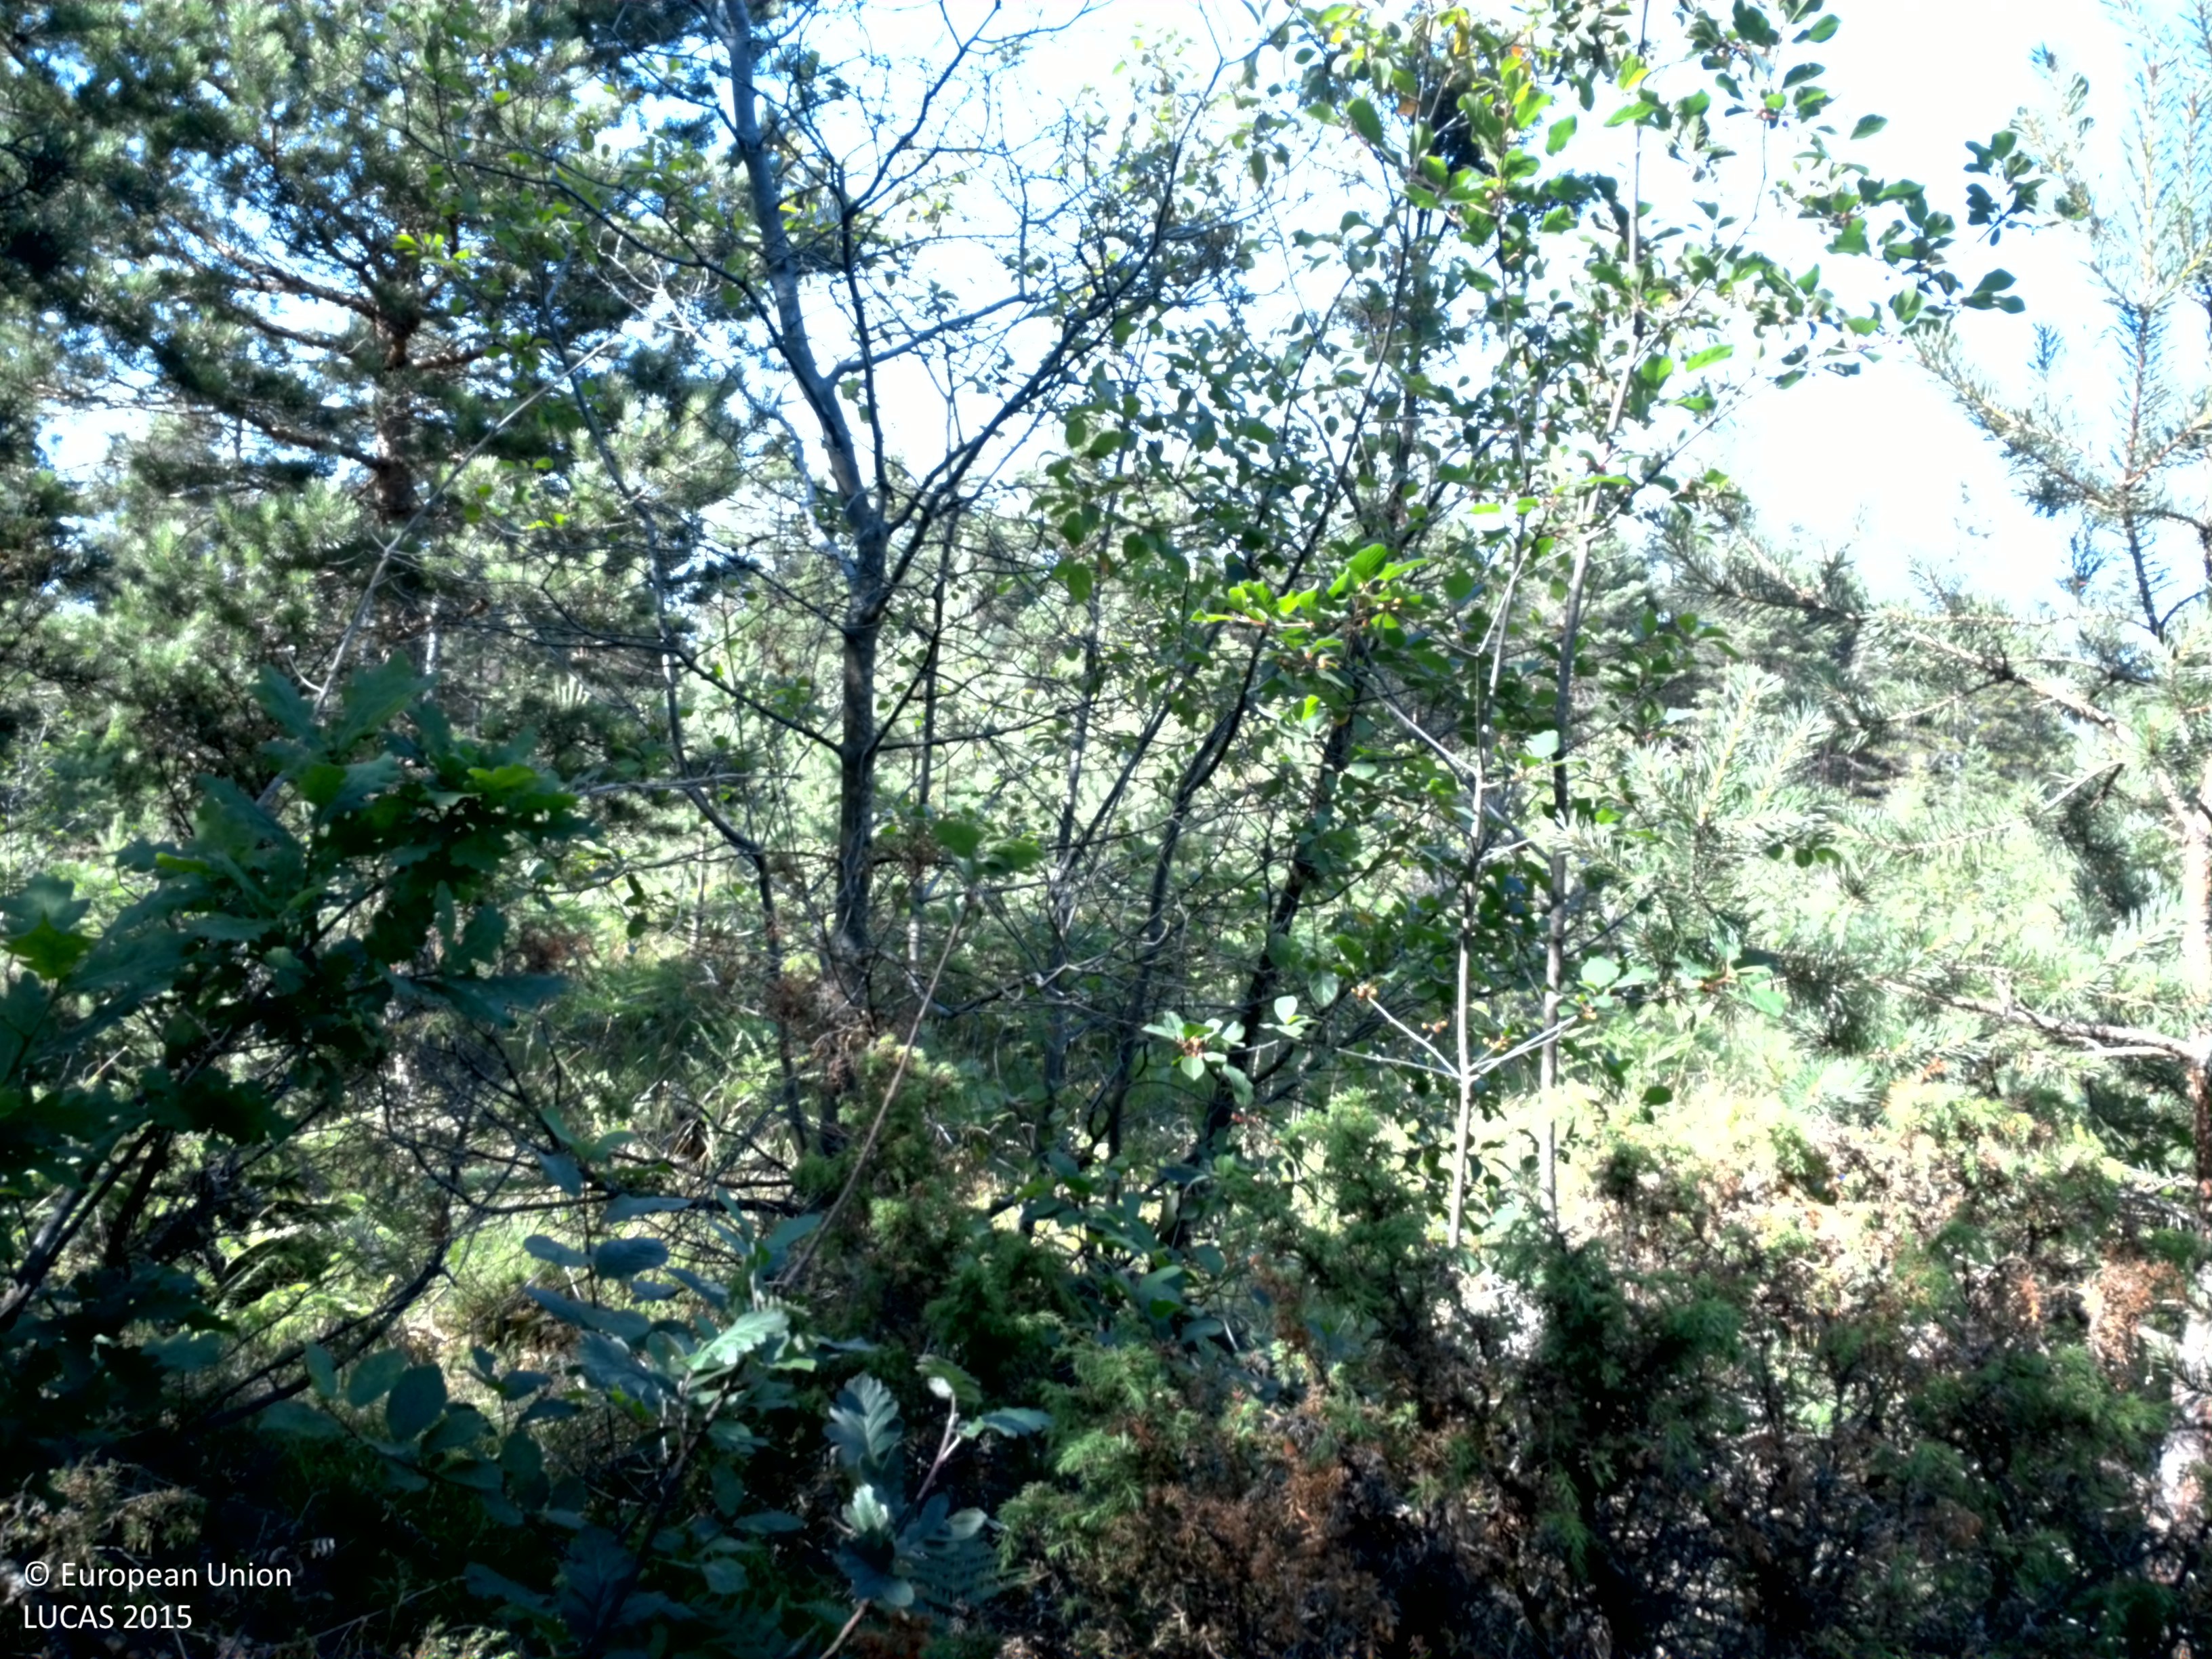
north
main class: Woodland
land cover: Pine dominated coniferous woodland
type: hemiboreal forest and nemoral coniferous forest and mixed broadleaved-coniferous forest
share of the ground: 50 - 75 %
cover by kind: coniferous forest trees 55 %, herbaceous plants 30 %, shrubs 15 %
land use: Forestry
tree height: > 5 m
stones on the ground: < 10 %
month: July
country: SE
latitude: 57.3462
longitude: 18.6011
